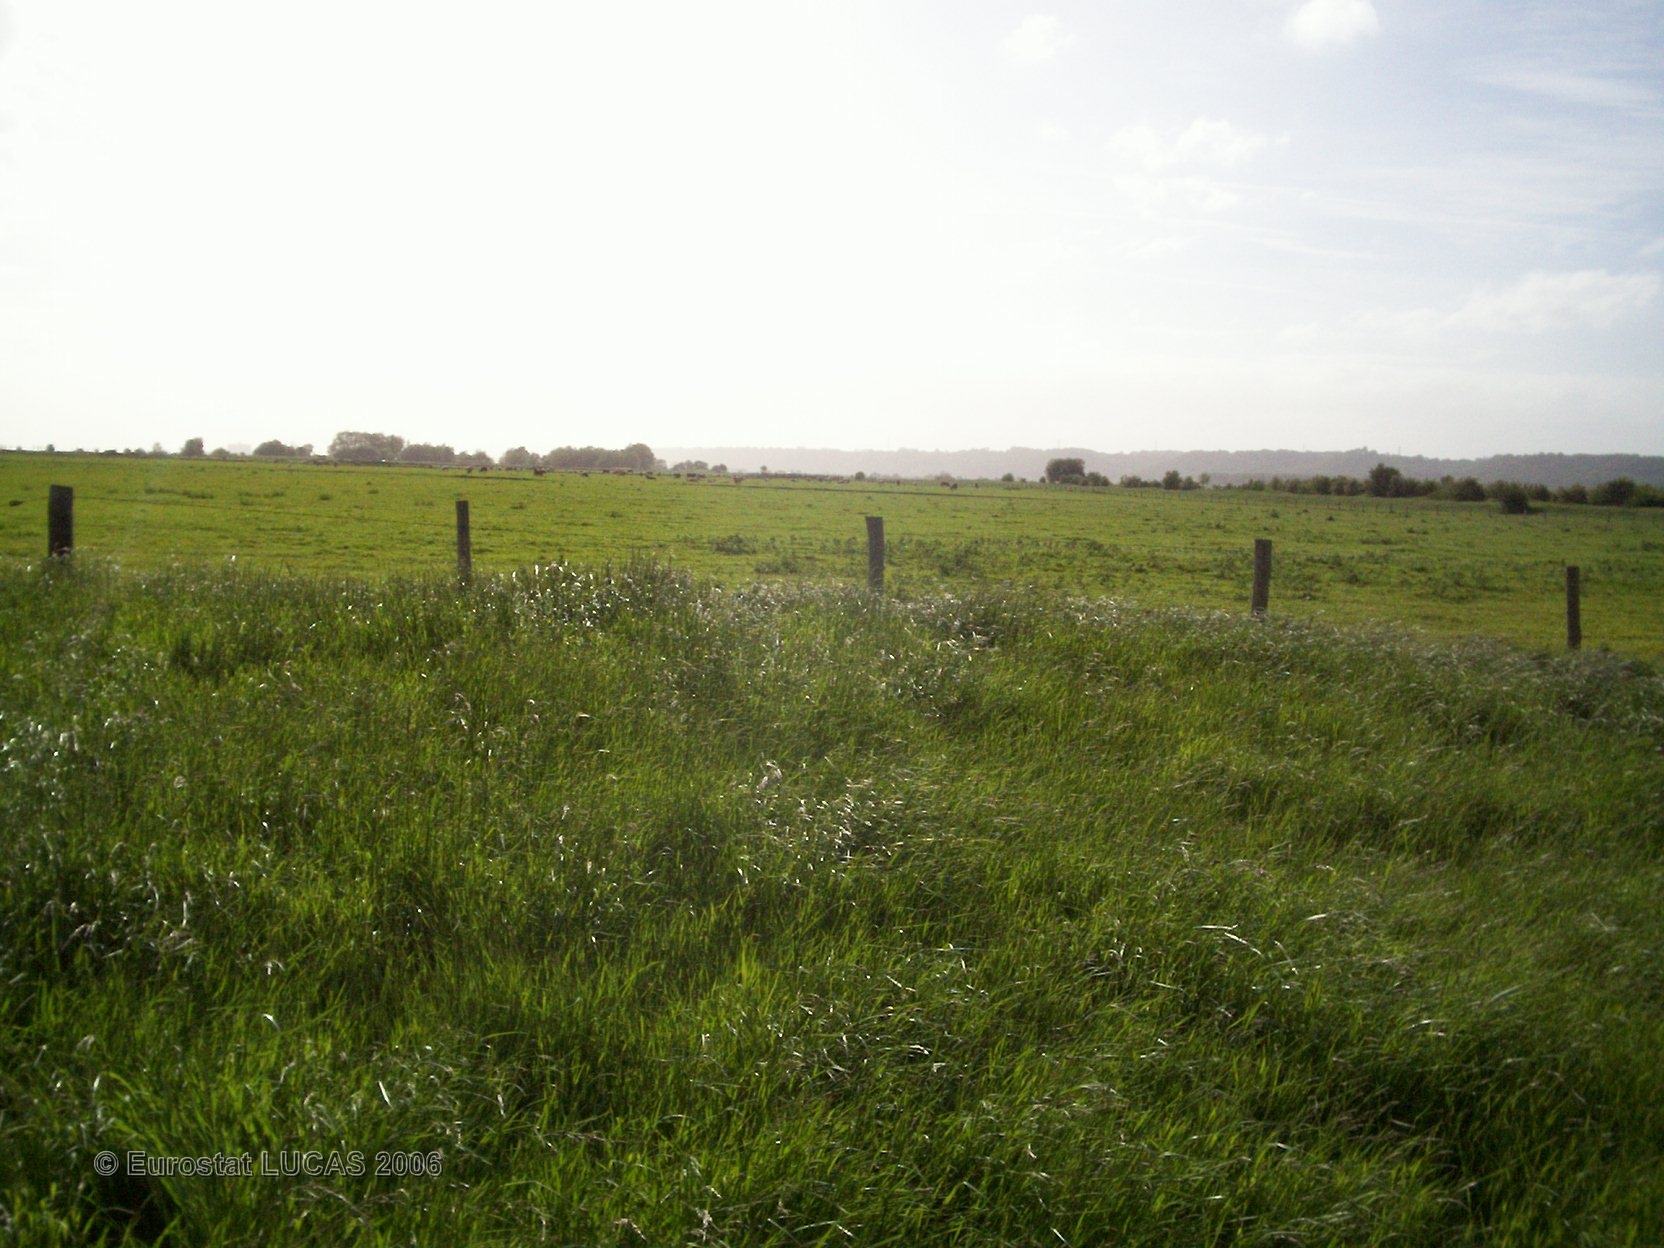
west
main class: Grassland
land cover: Grassland without tree/shrub cover
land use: Agriculture (excluding fallow land and kitchen gardens)
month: May
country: FR
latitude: 49.4735
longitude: 0.4366
